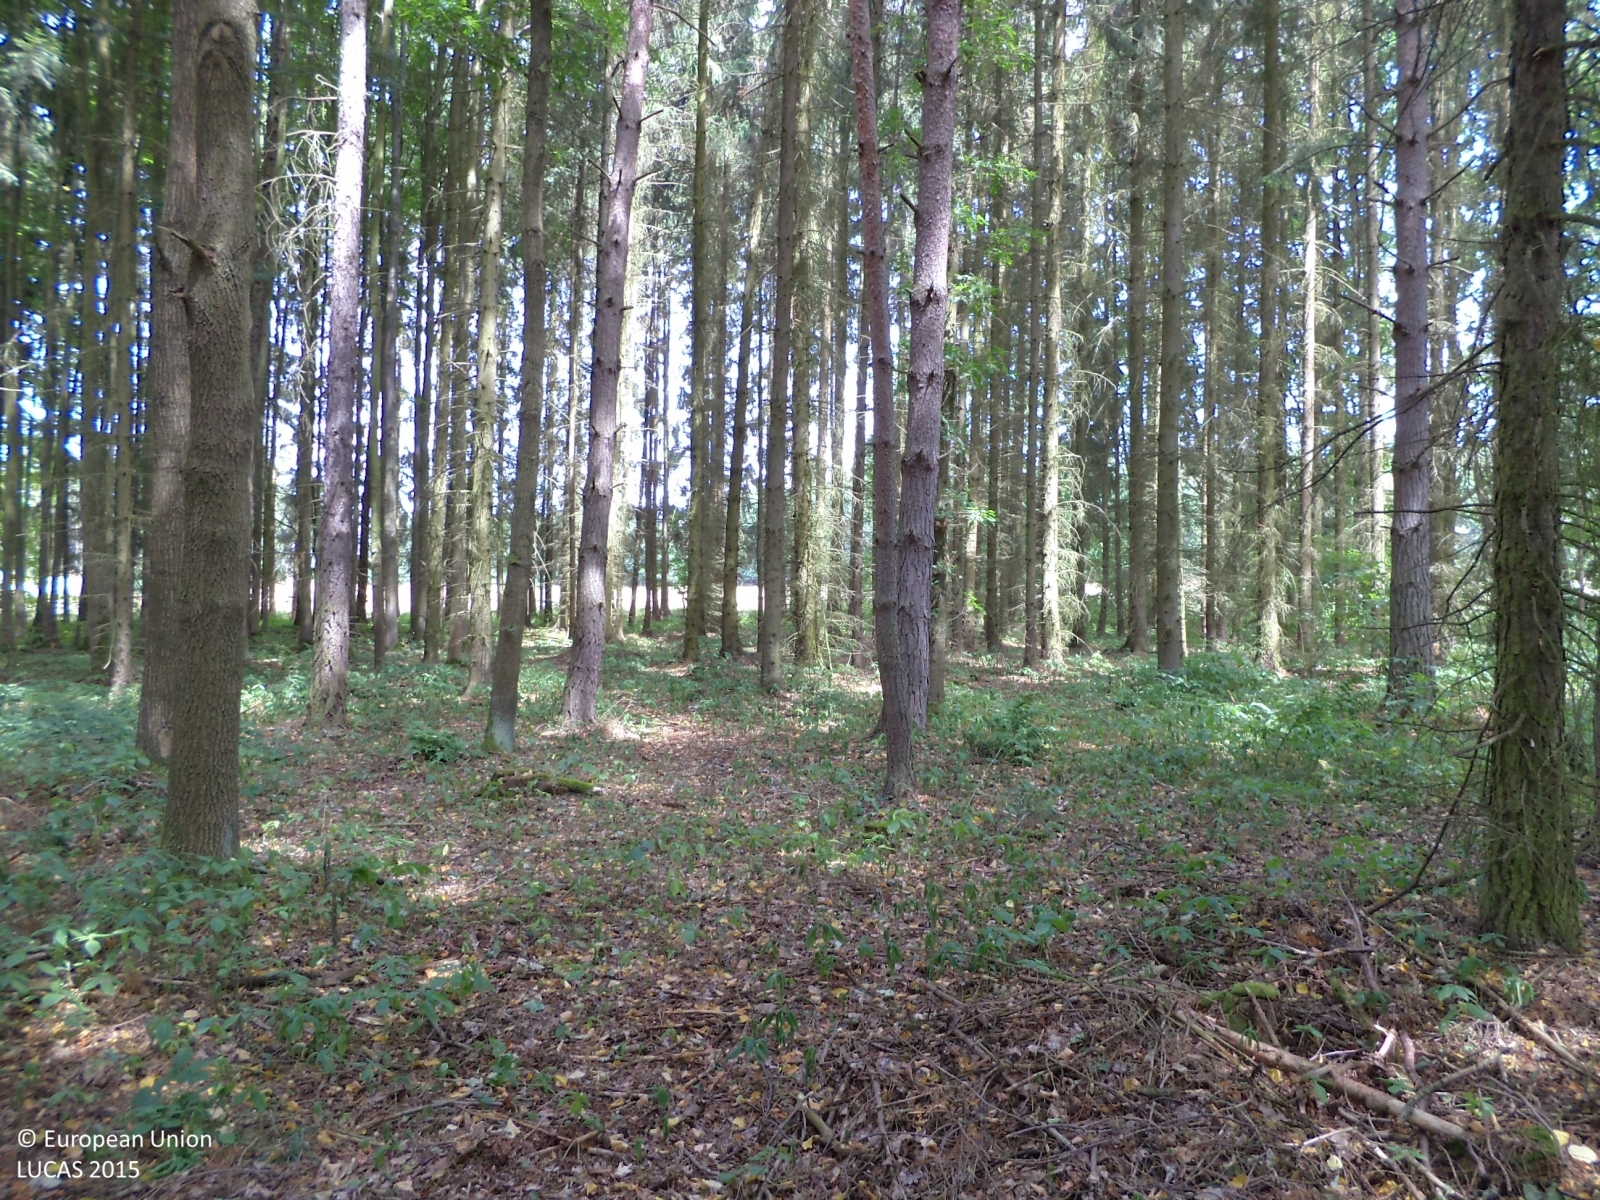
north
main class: Woodland
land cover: Spruce dominated mixed woodland
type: hemiboreal forest and nemoral coniferous forest and mixed broadleaved-coniferous forest
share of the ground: > 75 %
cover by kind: coniferous forest trees 70 %, broadleaved forest trees 30 %
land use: Forestry
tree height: > 5 m
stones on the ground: 10 - 25 %
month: July
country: CZ
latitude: 49.4522
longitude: 13.8768
